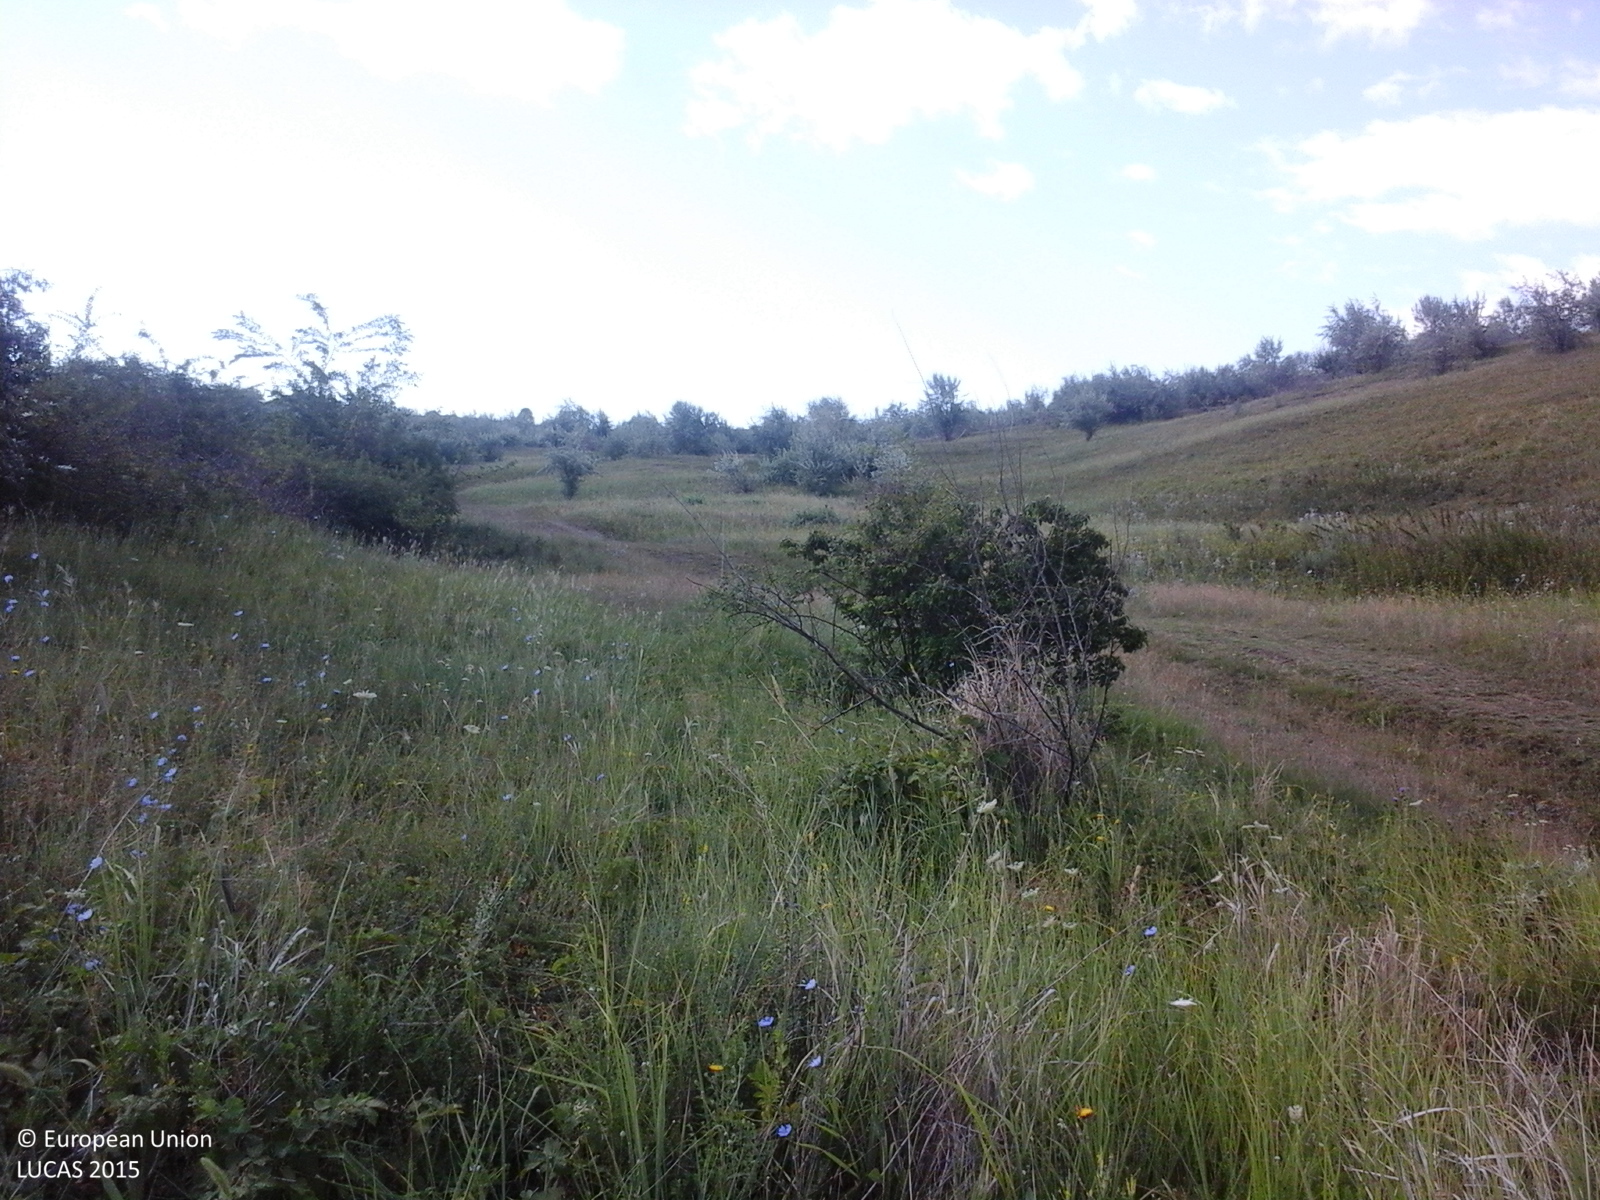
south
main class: Cropland
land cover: Maize
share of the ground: 10 - 25 %
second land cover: Spontaneously vegetated surfaces
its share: 25 - 50 %
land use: Agriculture (excluding fallow land and kitchen gardens)
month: July
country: RO
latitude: 46.3136
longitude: 27.8190
